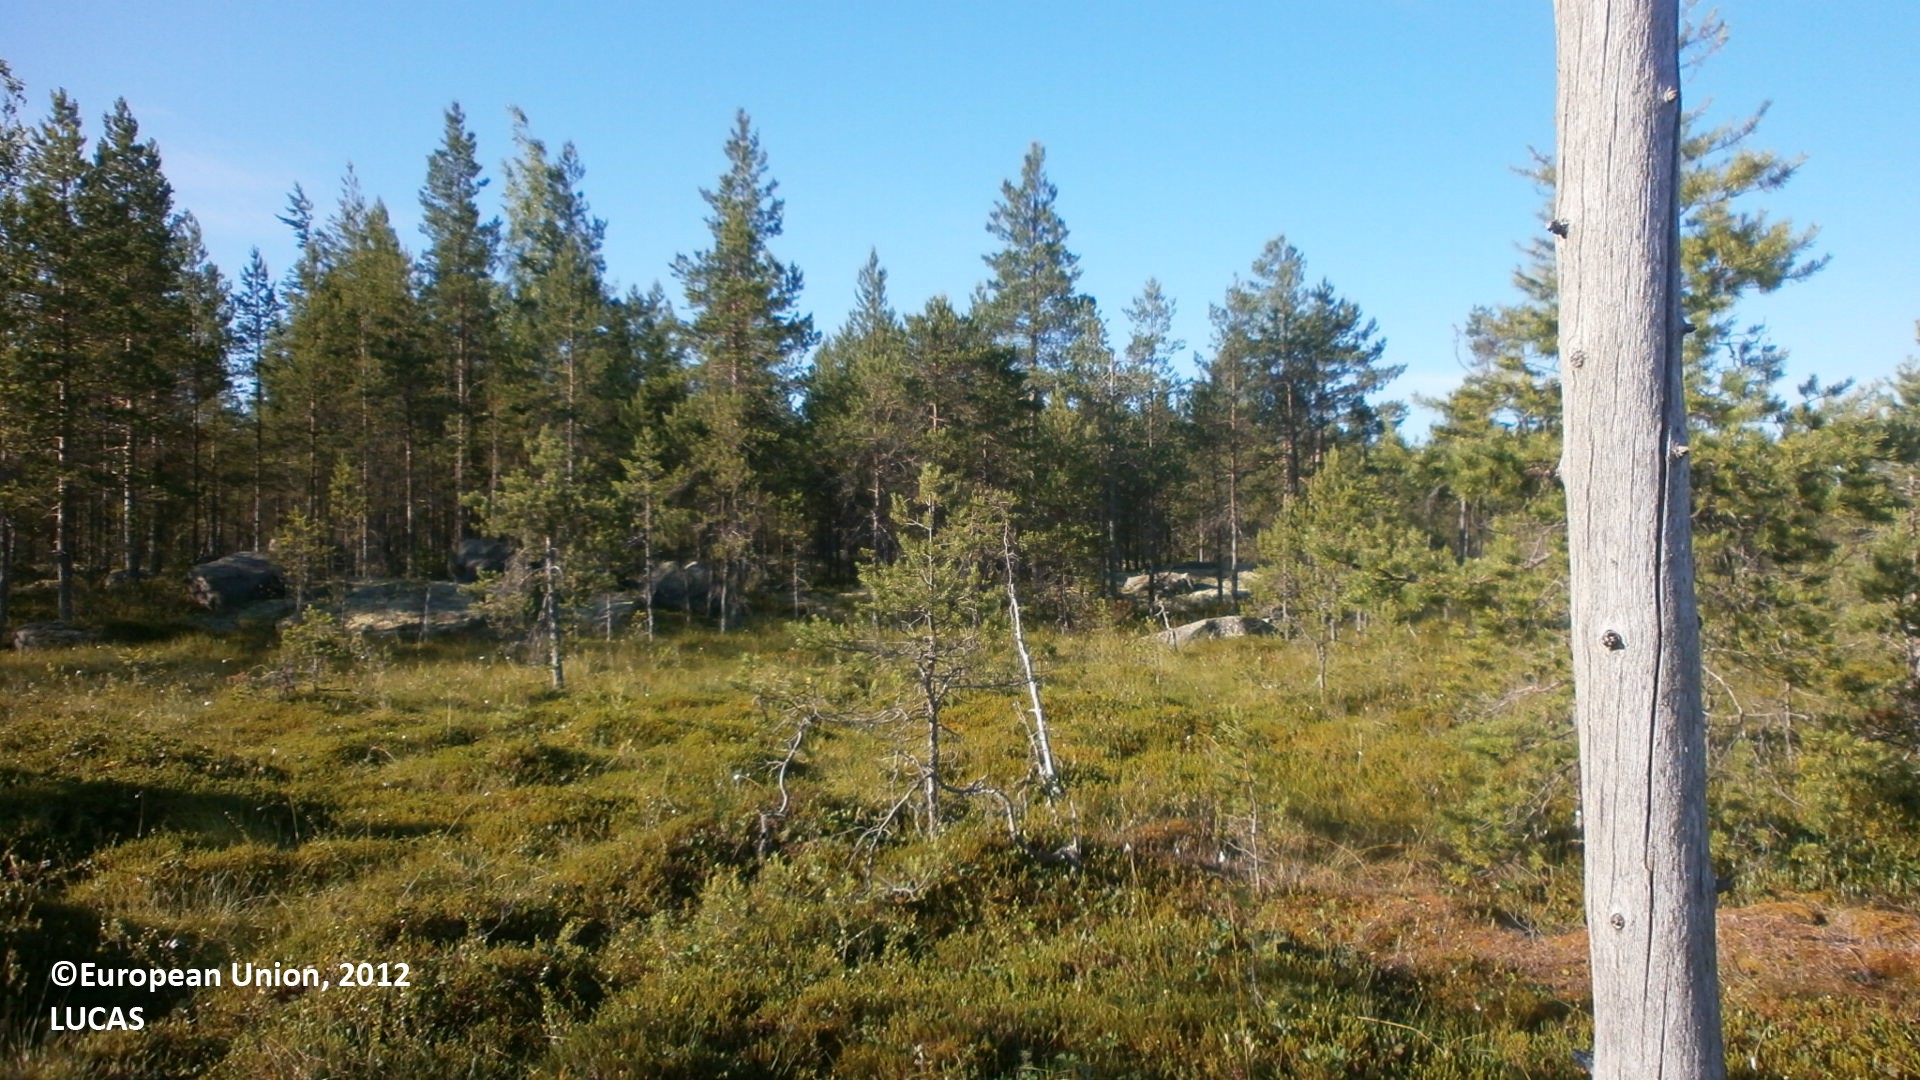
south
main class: Woodland
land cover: Pine dominated coniferous woodland
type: boreal forest
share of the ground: 10 - 25 %
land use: Semi-natural and natural areas not in use
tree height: < 5 m
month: July
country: FI
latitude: 64.0200
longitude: 24.1237
